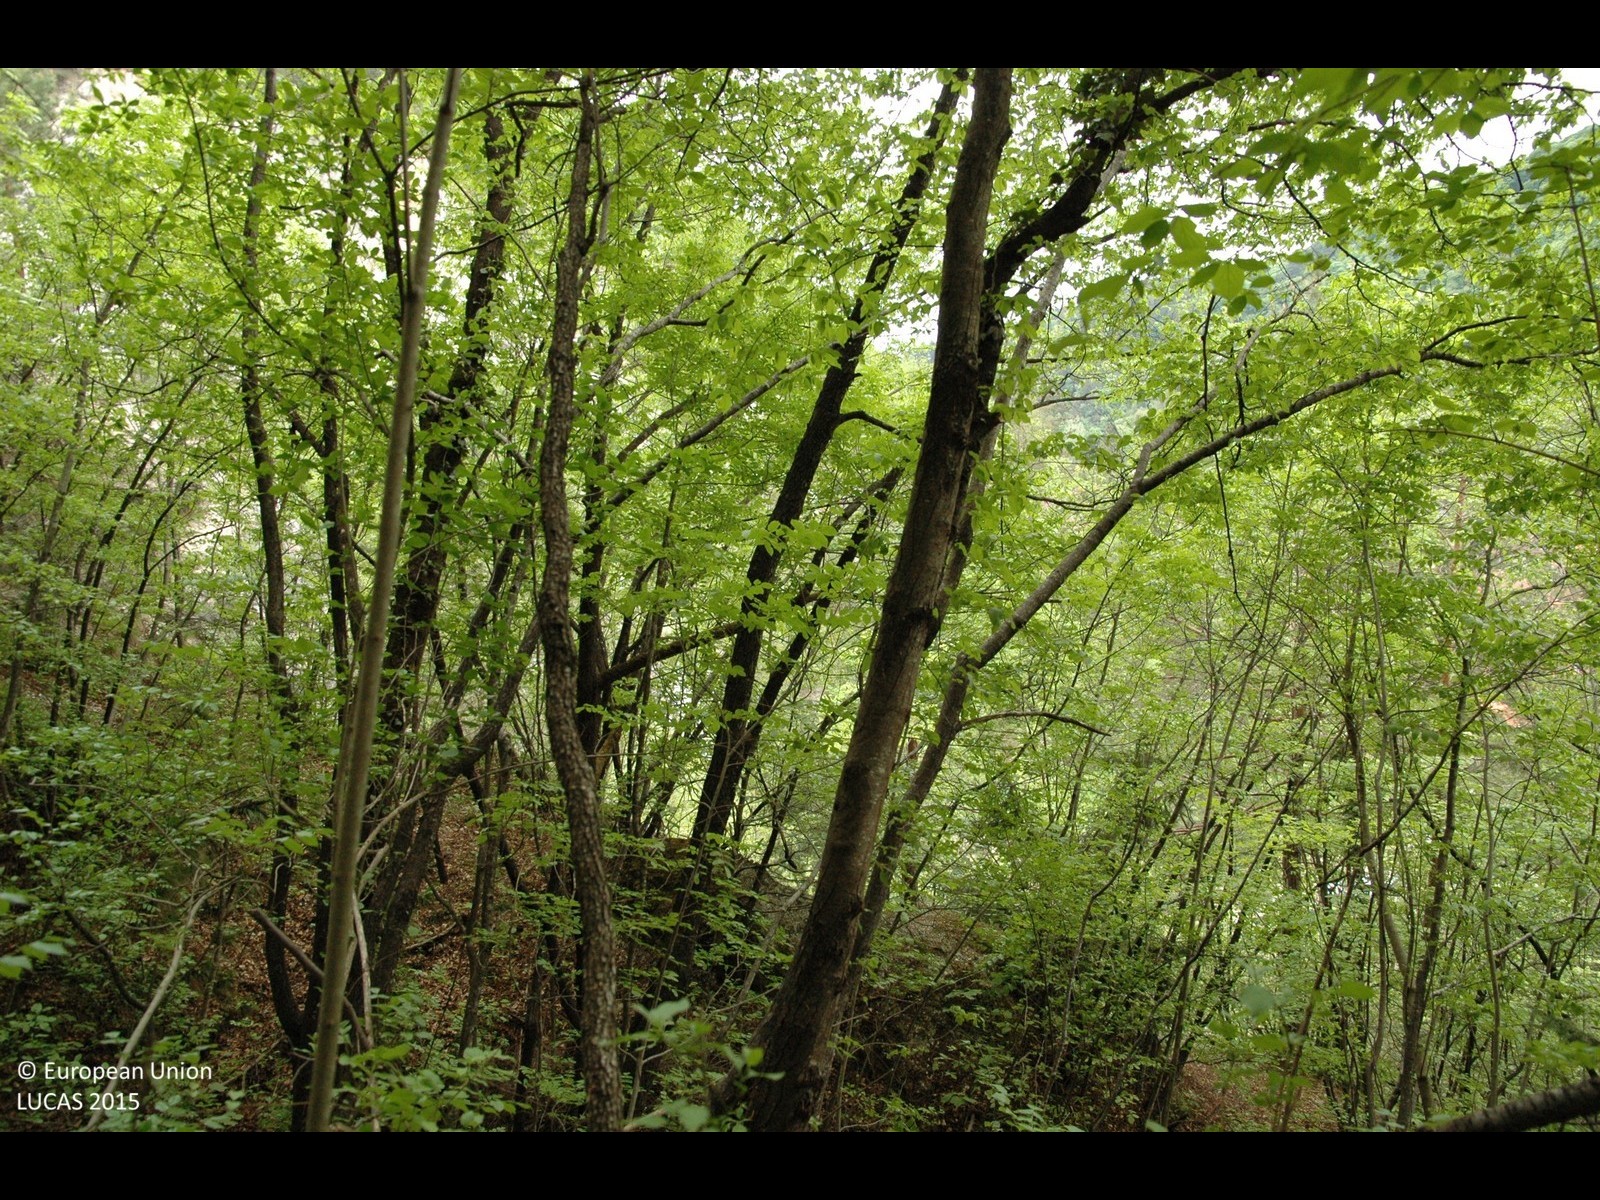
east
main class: Woodland
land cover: Broadleaved woodland
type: beech forest
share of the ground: > 75 %
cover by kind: broadleaved forest trees 95 %, consolidated bare surface 5 %
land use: Forestry
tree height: > 5 m
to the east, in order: Broadleaved woodland; Spontaneously vegetated surfaces; Broadleaved woodland
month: May
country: HR
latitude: 45.8021
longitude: 15.6972
